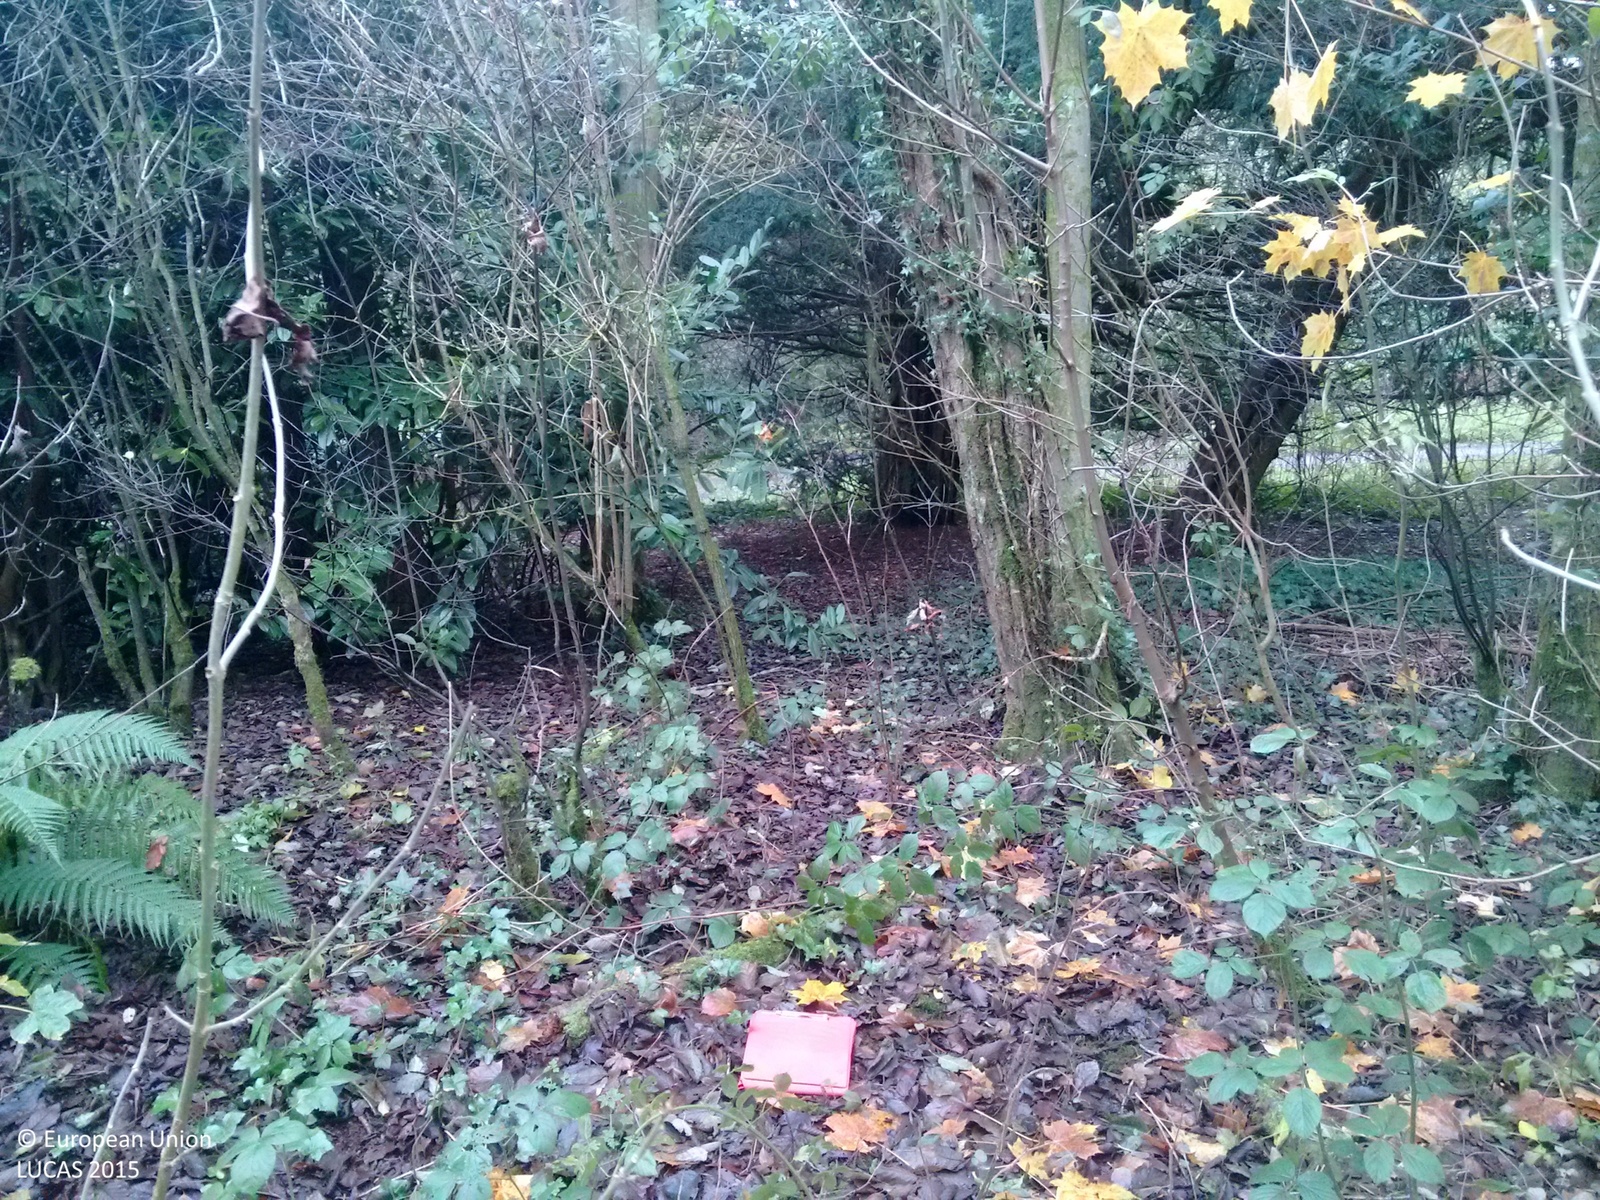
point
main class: Woodland
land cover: Other mixed woodland
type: exotic forest
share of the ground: > 75 %
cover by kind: broadleaved forest trees 60 %, coniferous forest trees 30 %, herbaceous plants 10 %
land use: Amenities, museums, leisure
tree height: > 5 m
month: November
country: GB
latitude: 54.5589
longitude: -5.9271
